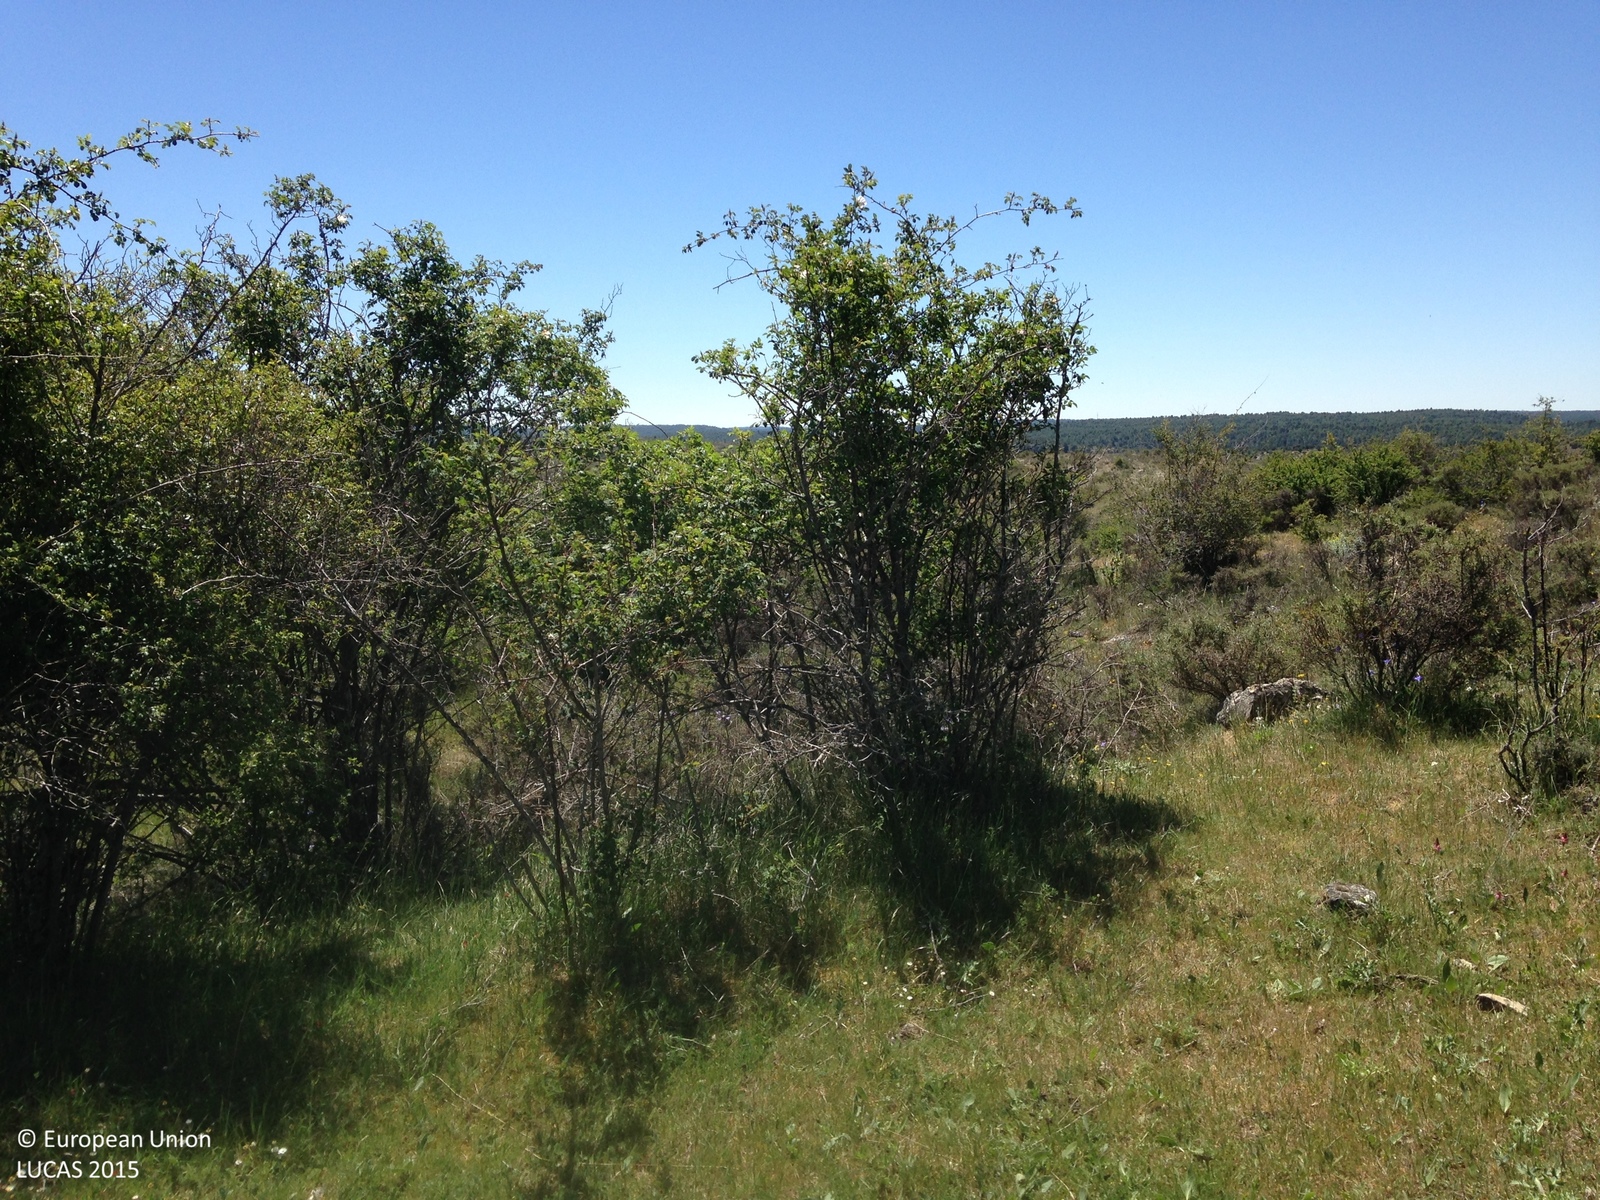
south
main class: Shrubland
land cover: Shrubland without tree cover
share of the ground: 50 - 75 %
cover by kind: shrubs 65 %, herbaceous plants 20 %, consolidated bare surface 15 %
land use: Semi-natural and natural areas not in use
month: May
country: ES
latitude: 40.5473
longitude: -2.0291
